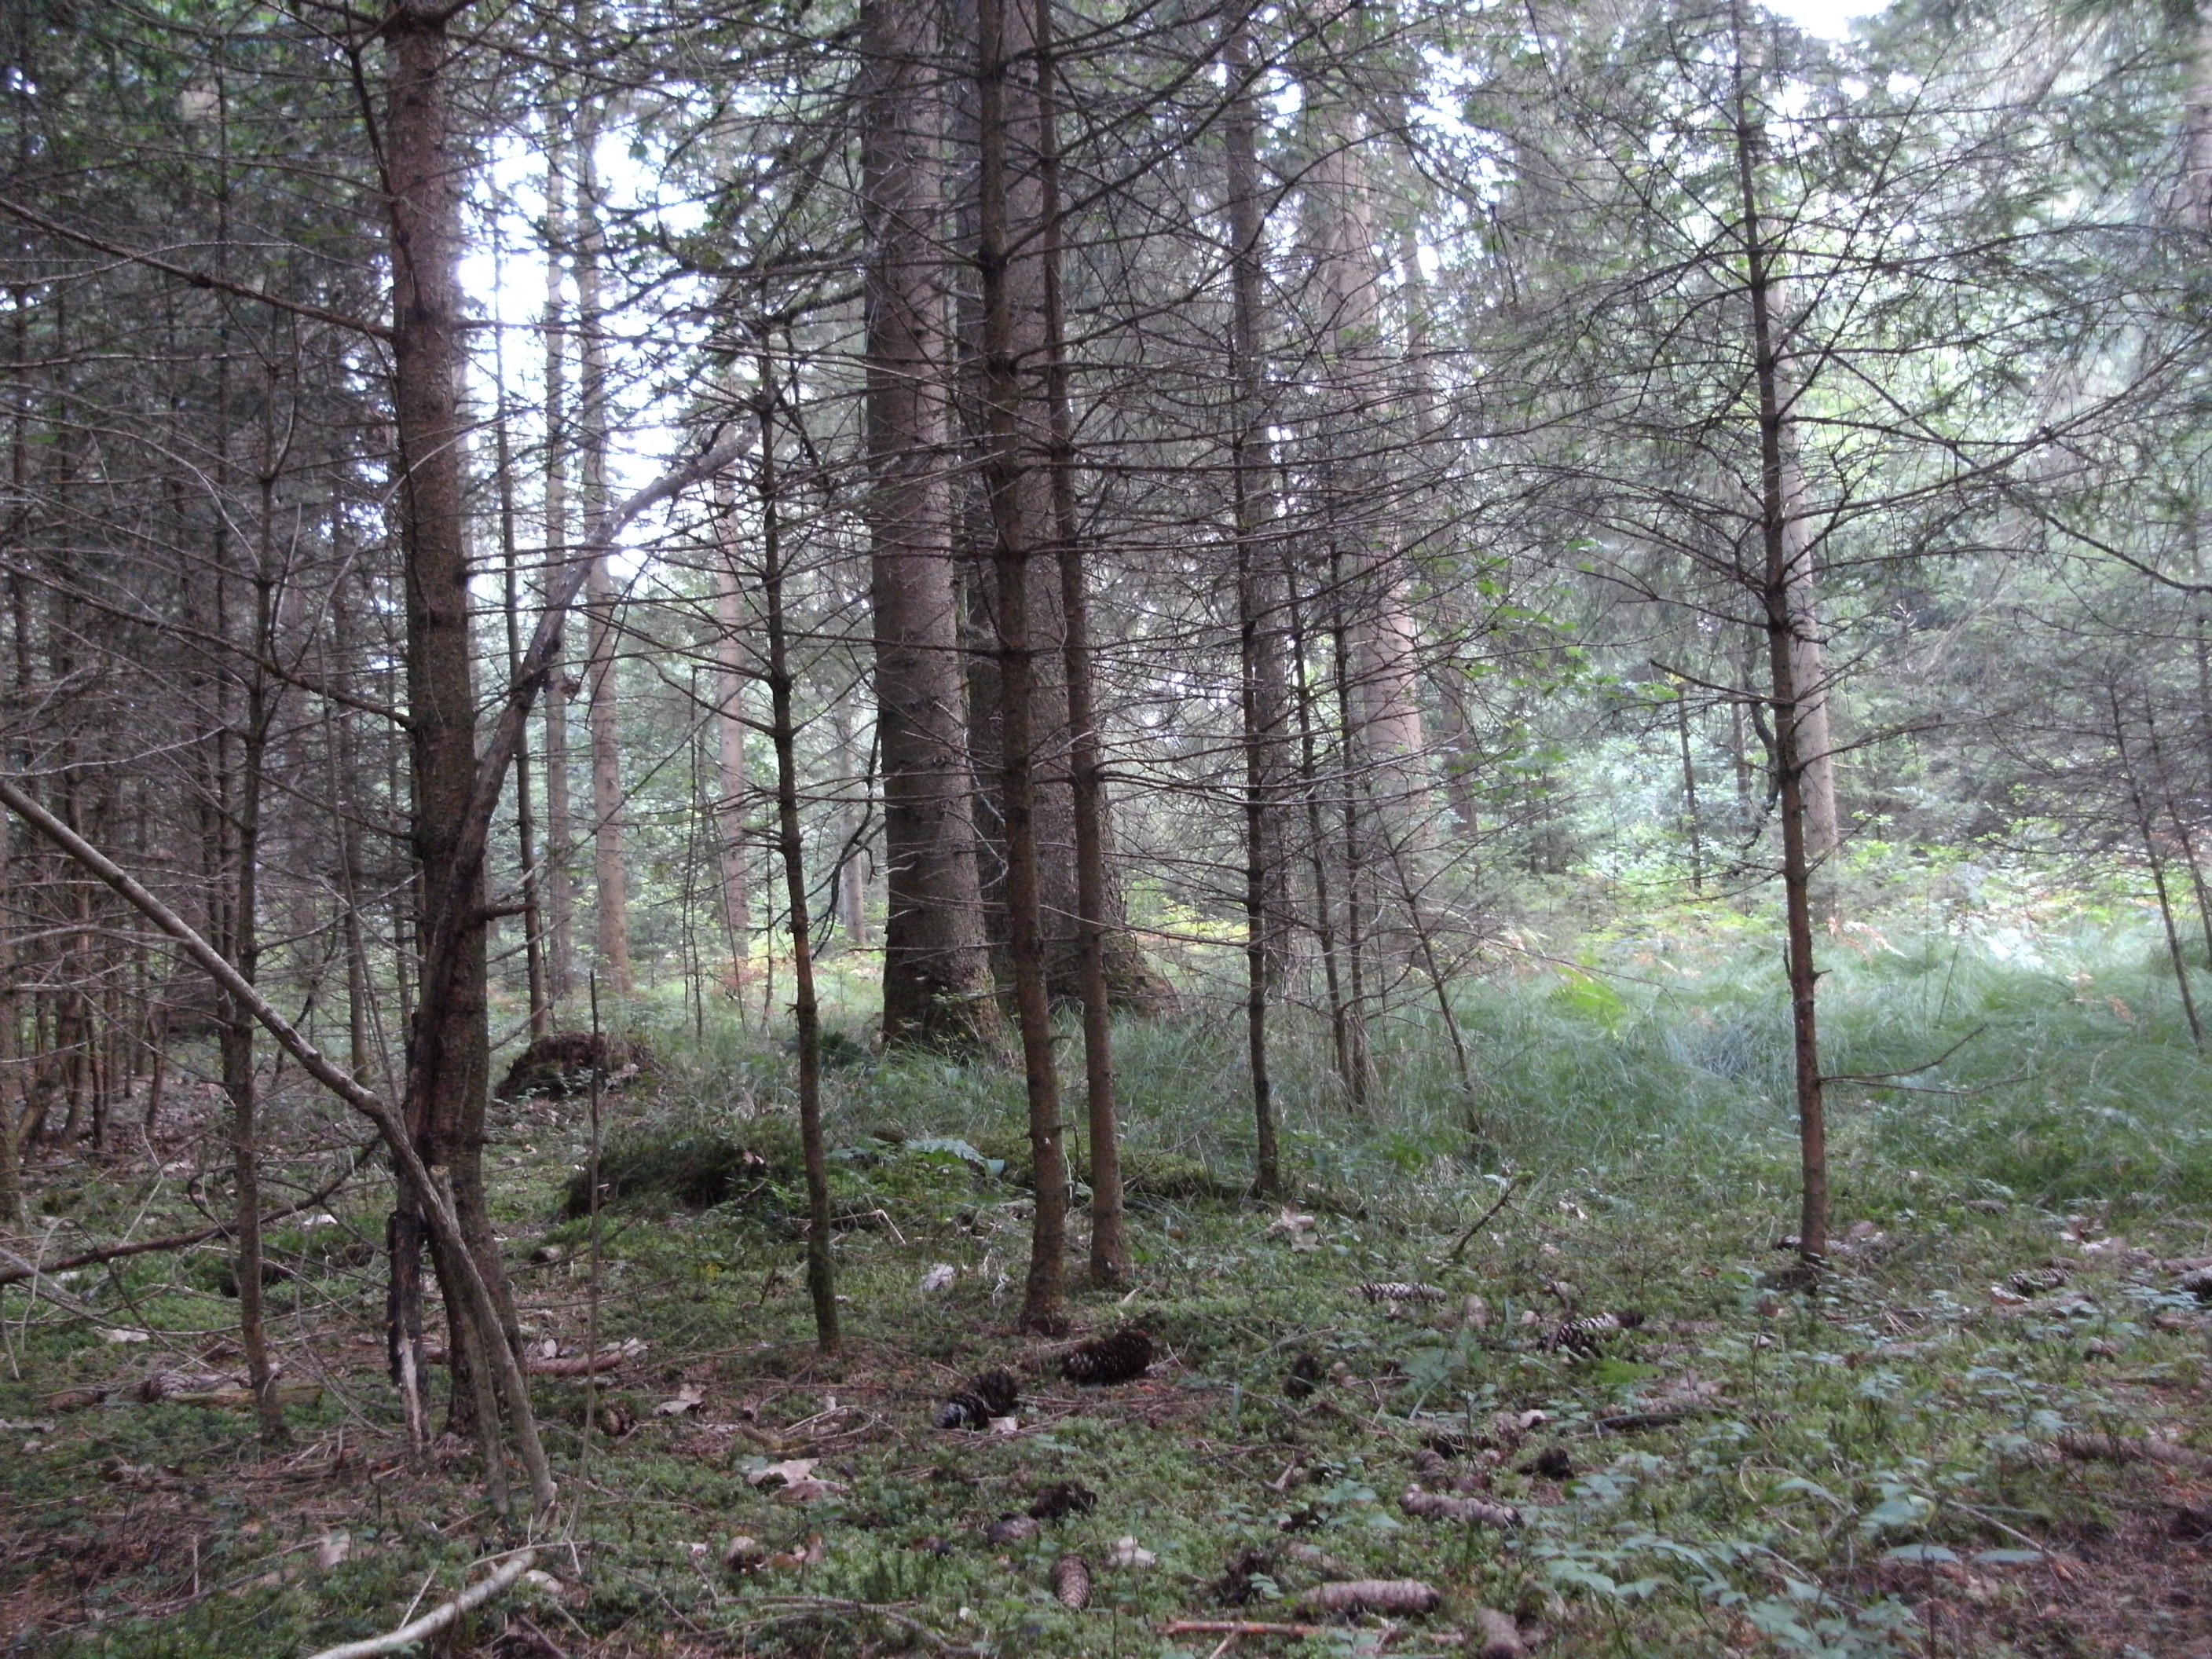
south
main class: Woodland
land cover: Spruce dominated coniferous woodland
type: hemiboreal forest and nemoral coniferous forest and mixed broadleaved-coniferous forest
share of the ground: > 75 %
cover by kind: coniferous forest trees 75 %, broadleaved forest trees 15 %, shrubs 5 %, herbaceous plants 5 %
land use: Forestry
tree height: > 5 m
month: July
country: AT
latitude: 46.6059
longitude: 14.7631
